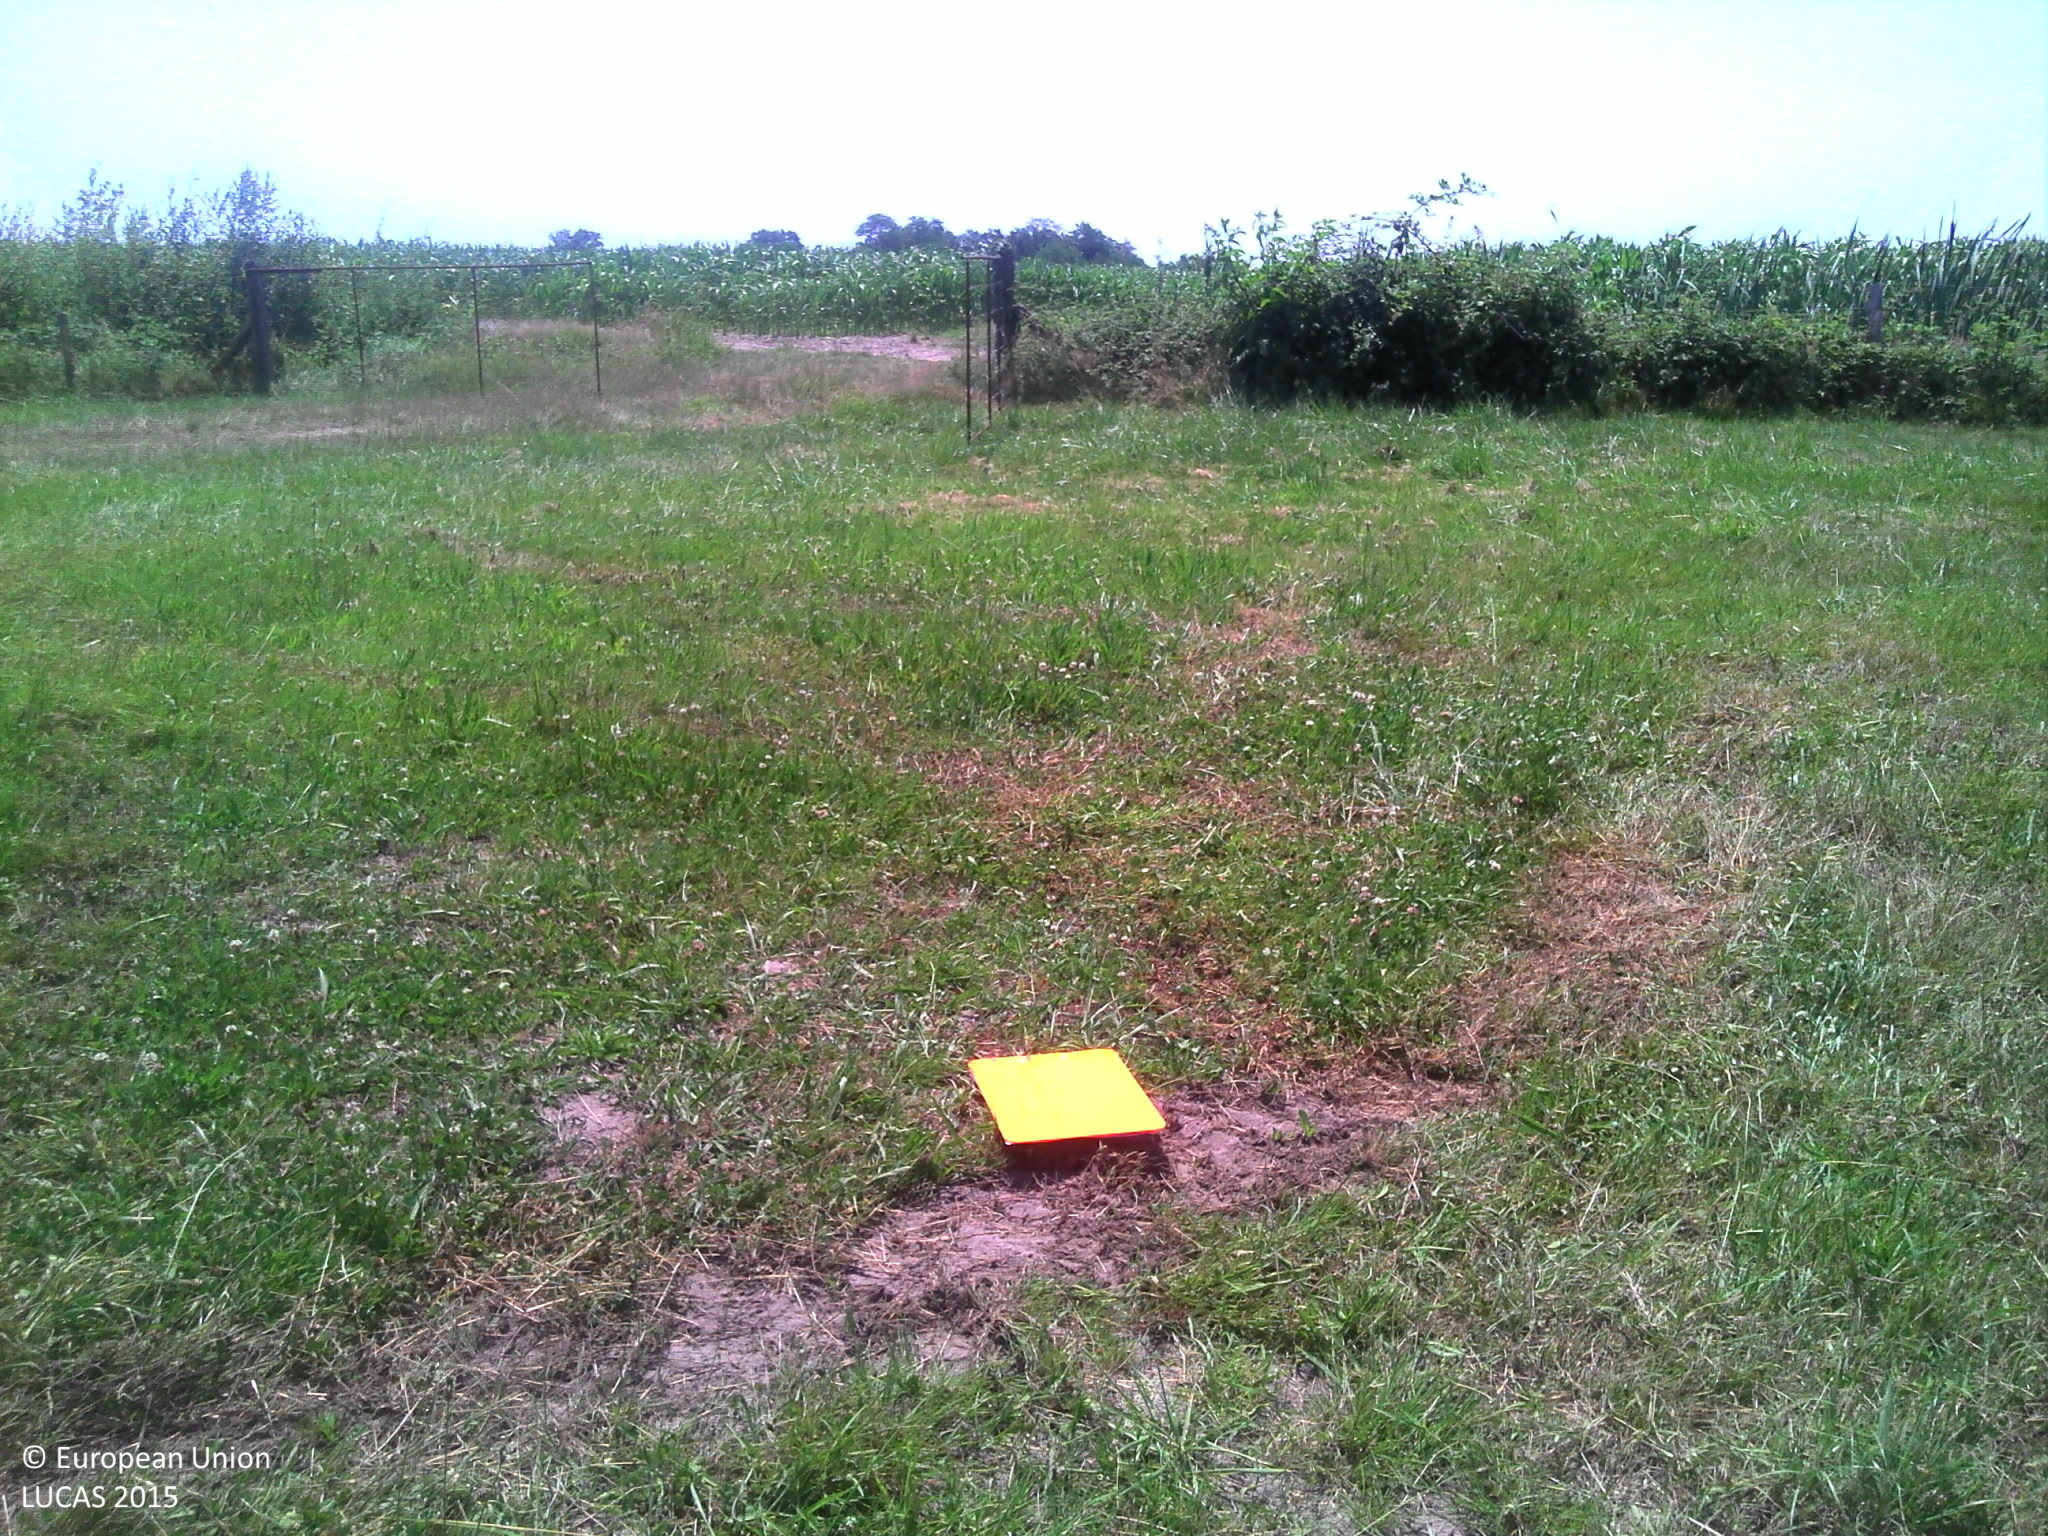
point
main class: Grassland
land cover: Grassland with sparse tree/shrub cover
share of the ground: > 75 %
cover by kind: herbaceous plants 95 %, broadleaved forest trees 5 %
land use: Agriculture (excluding fallow land and kitchen gardens)
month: June
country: FR
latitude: 43.9671
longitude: -0.2683
